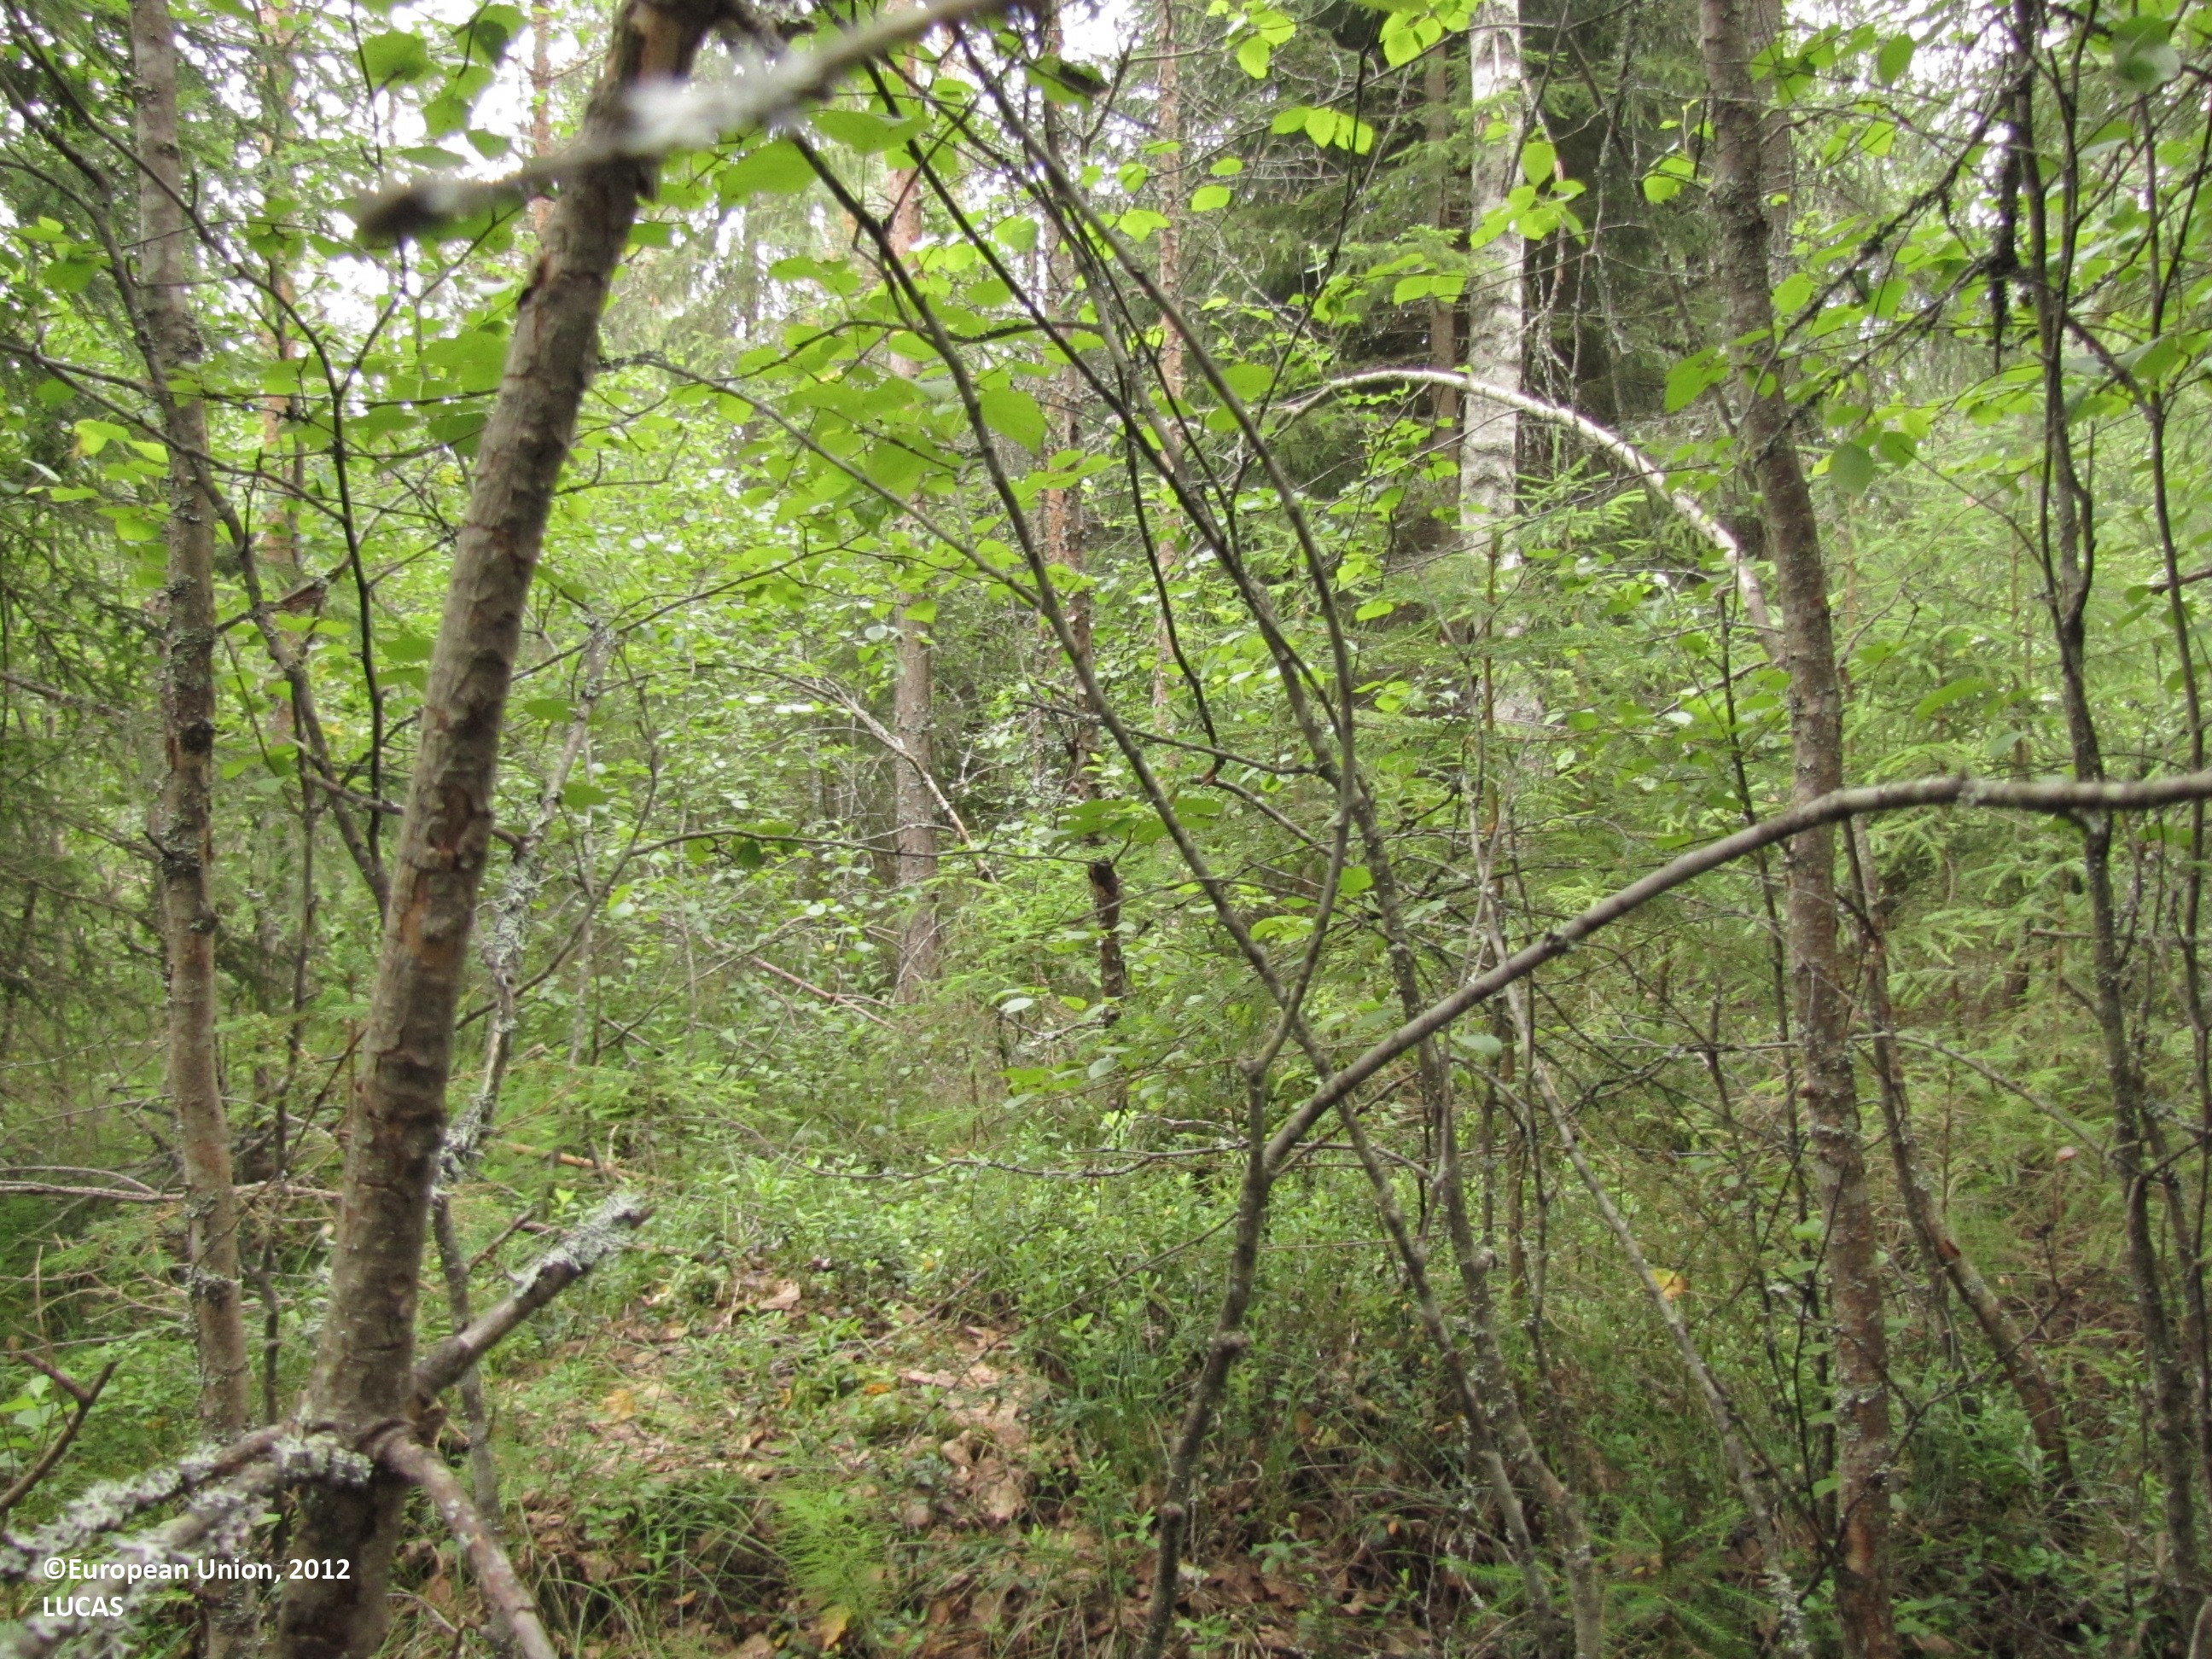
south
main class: Woodland
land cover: Pine dominated mixed woodland
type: mire and swamp forests
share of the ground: > 75 %
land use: Forestry
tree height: > 5 m
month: July
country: FI
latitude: 62.2809
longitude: 23.0350
